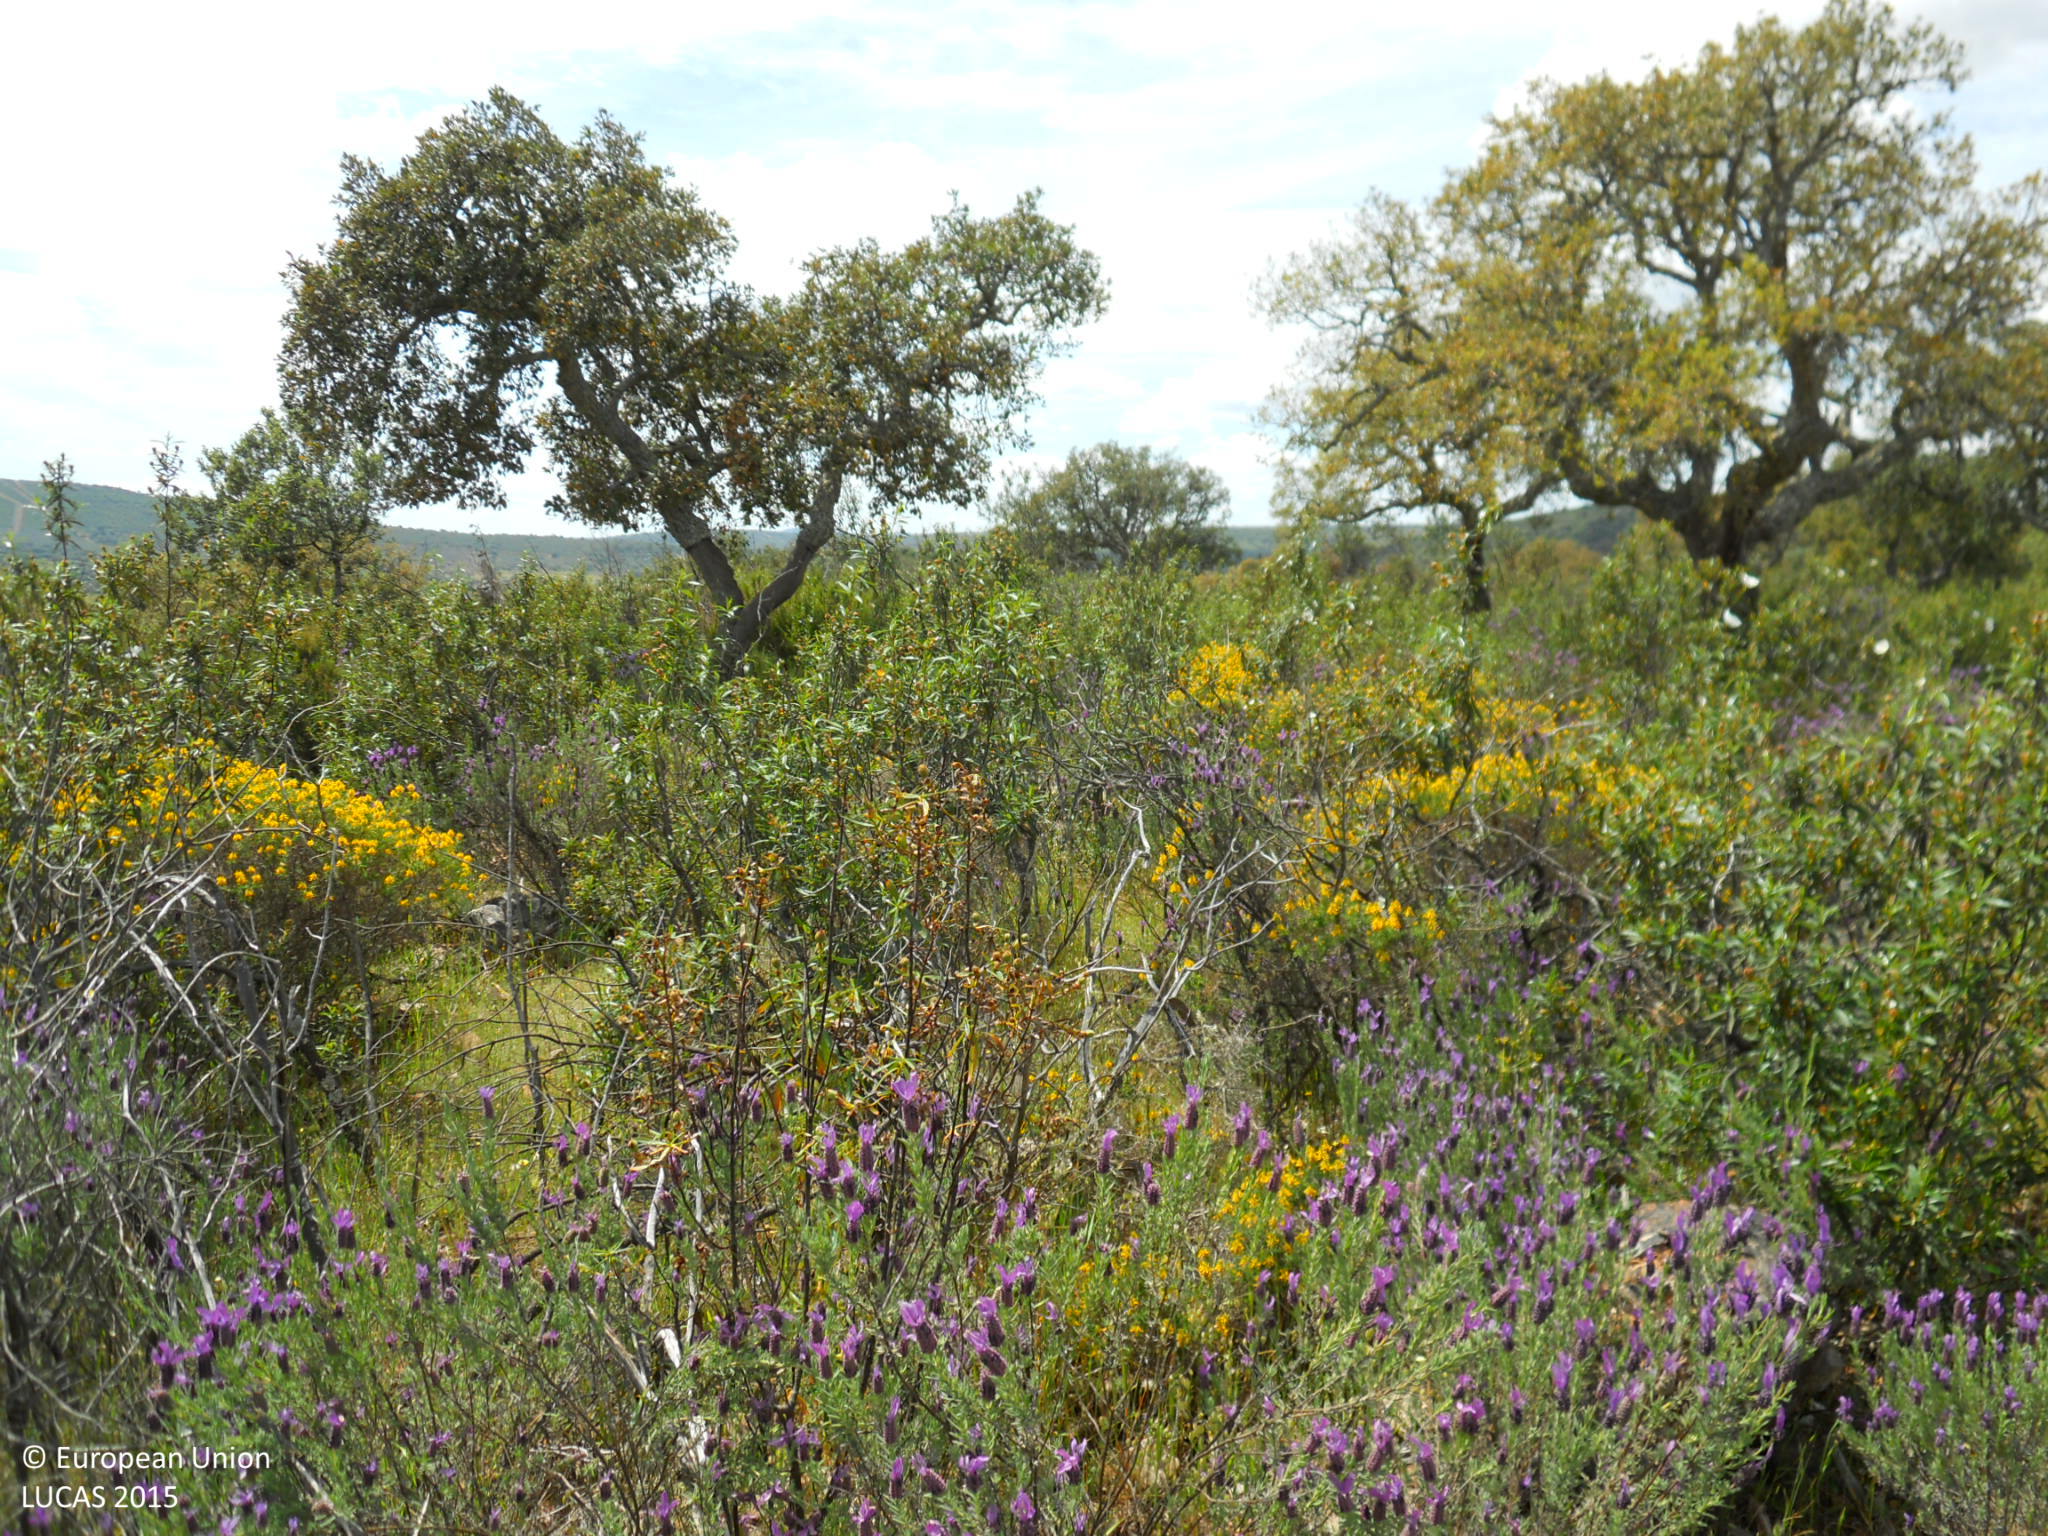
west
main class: Shrubland
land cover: Shrubland with sparse tree cover
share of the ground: > 75 %
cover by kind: shrubs 85 %, herbaceous plants 10 %, broadleaved forest trees 5 %
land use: Forestry
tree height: > 5 m
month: April
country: ES
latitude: 39.3115
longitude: -6.5491
